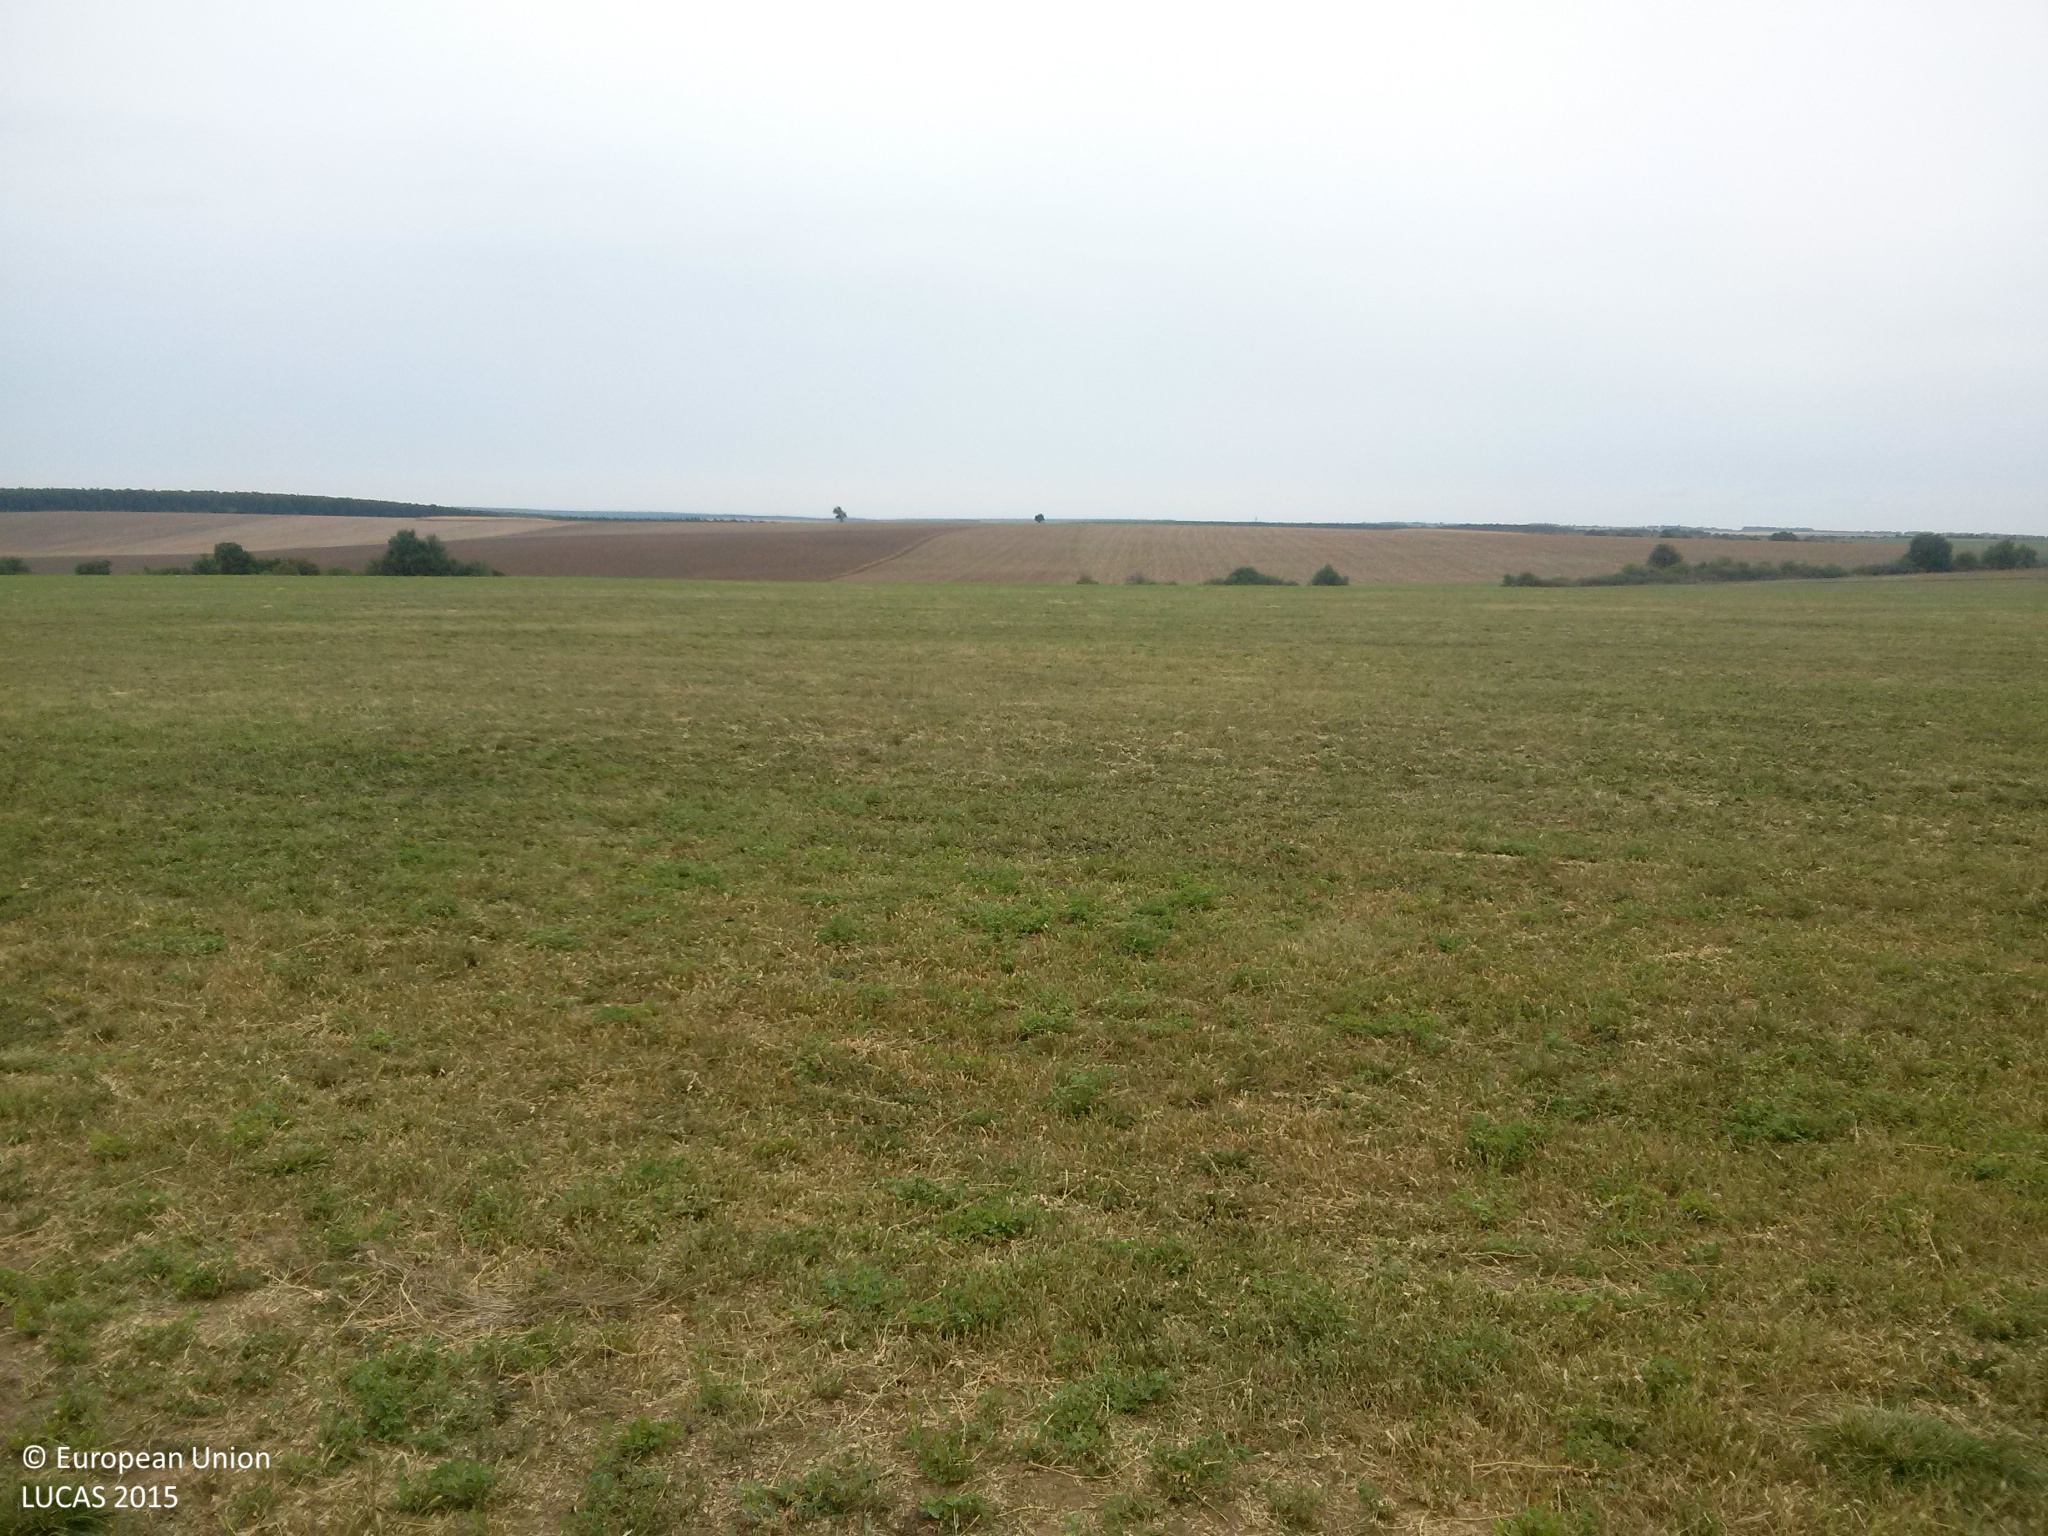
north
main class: Cropland
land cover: Lucerne
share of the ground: 50 - 75 %
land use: Agriculture (excluding fallow land and kitchen gardens)
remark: Harvested field
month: September
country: BG
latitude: 43.7469
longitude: 26.7670
